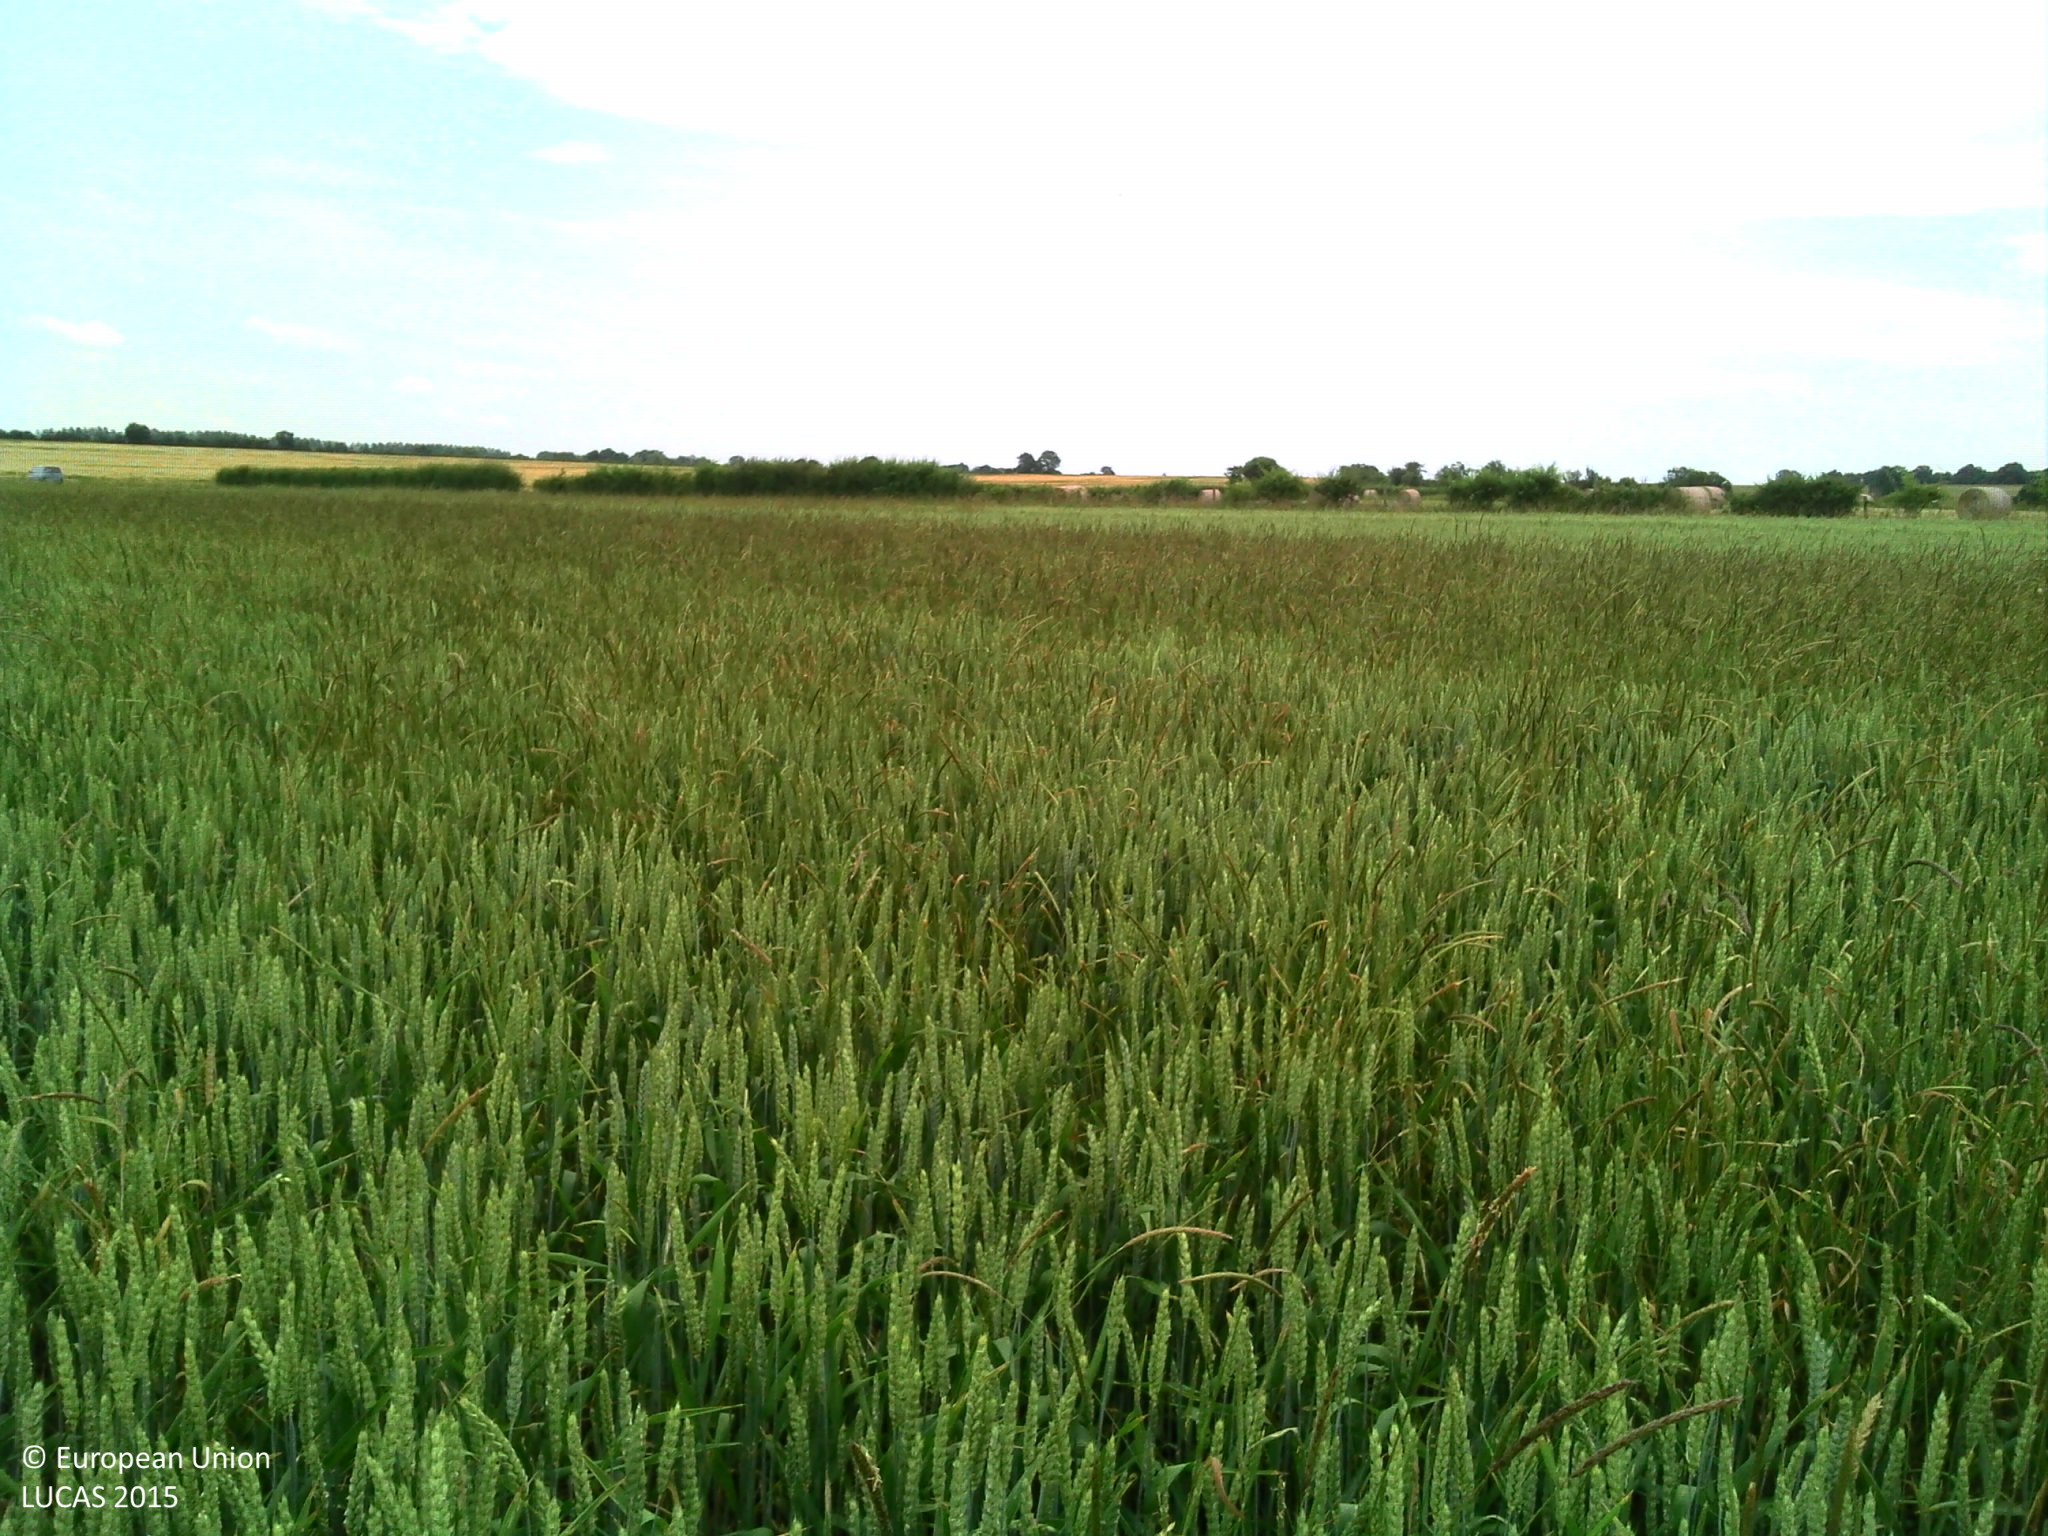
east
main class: Cropland
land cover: Common wheat
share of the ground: > 75 %
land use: Agriculture (excluding fallow land and kitchen gardens)
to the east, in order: Common wheat; Ditches and canals; Grass margins; Paved roads, cycling and walking lanes; Grass margins; Ditches and canals; Managed hedges; Grassland without tree/shrub cover; Managed hedges; Barley
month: June
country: FR
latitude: 46.7885
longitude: 2.6985
